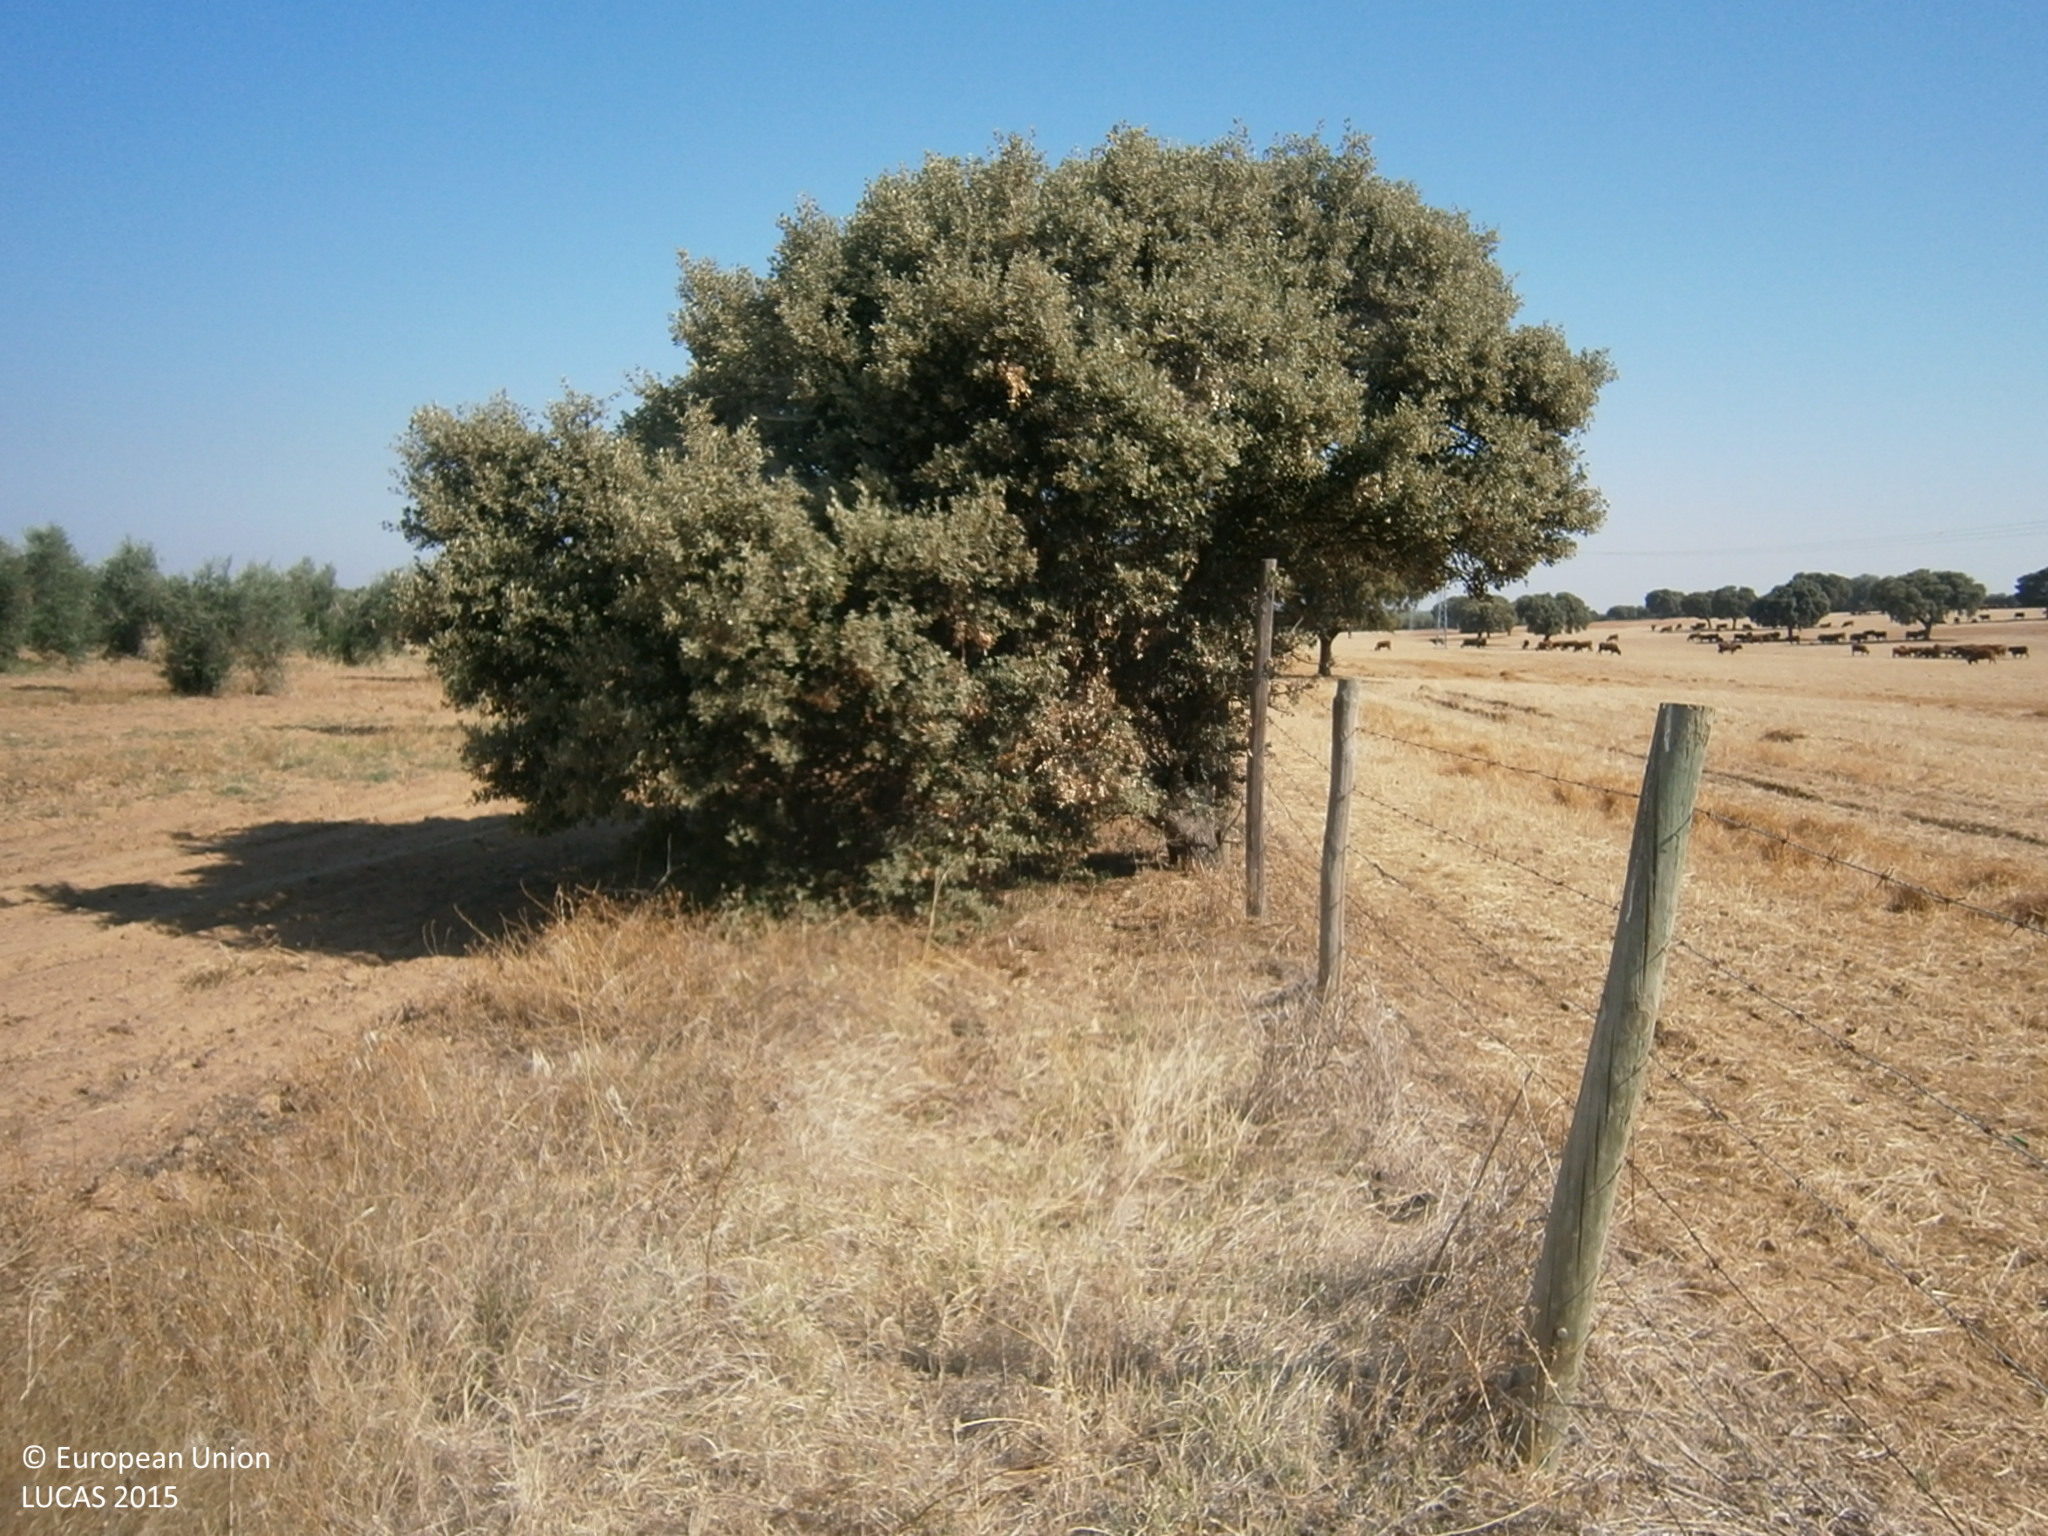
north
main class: Grassland
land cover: Grassland without tree/shrub cover
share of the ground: > 75 %
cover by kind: herbaceous plants 95 %, shrubs 5 %
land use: Agriculture (excluding fallow land and kitchen gardens)
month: June
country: ES
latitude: 38.8154
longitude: -6.7519
